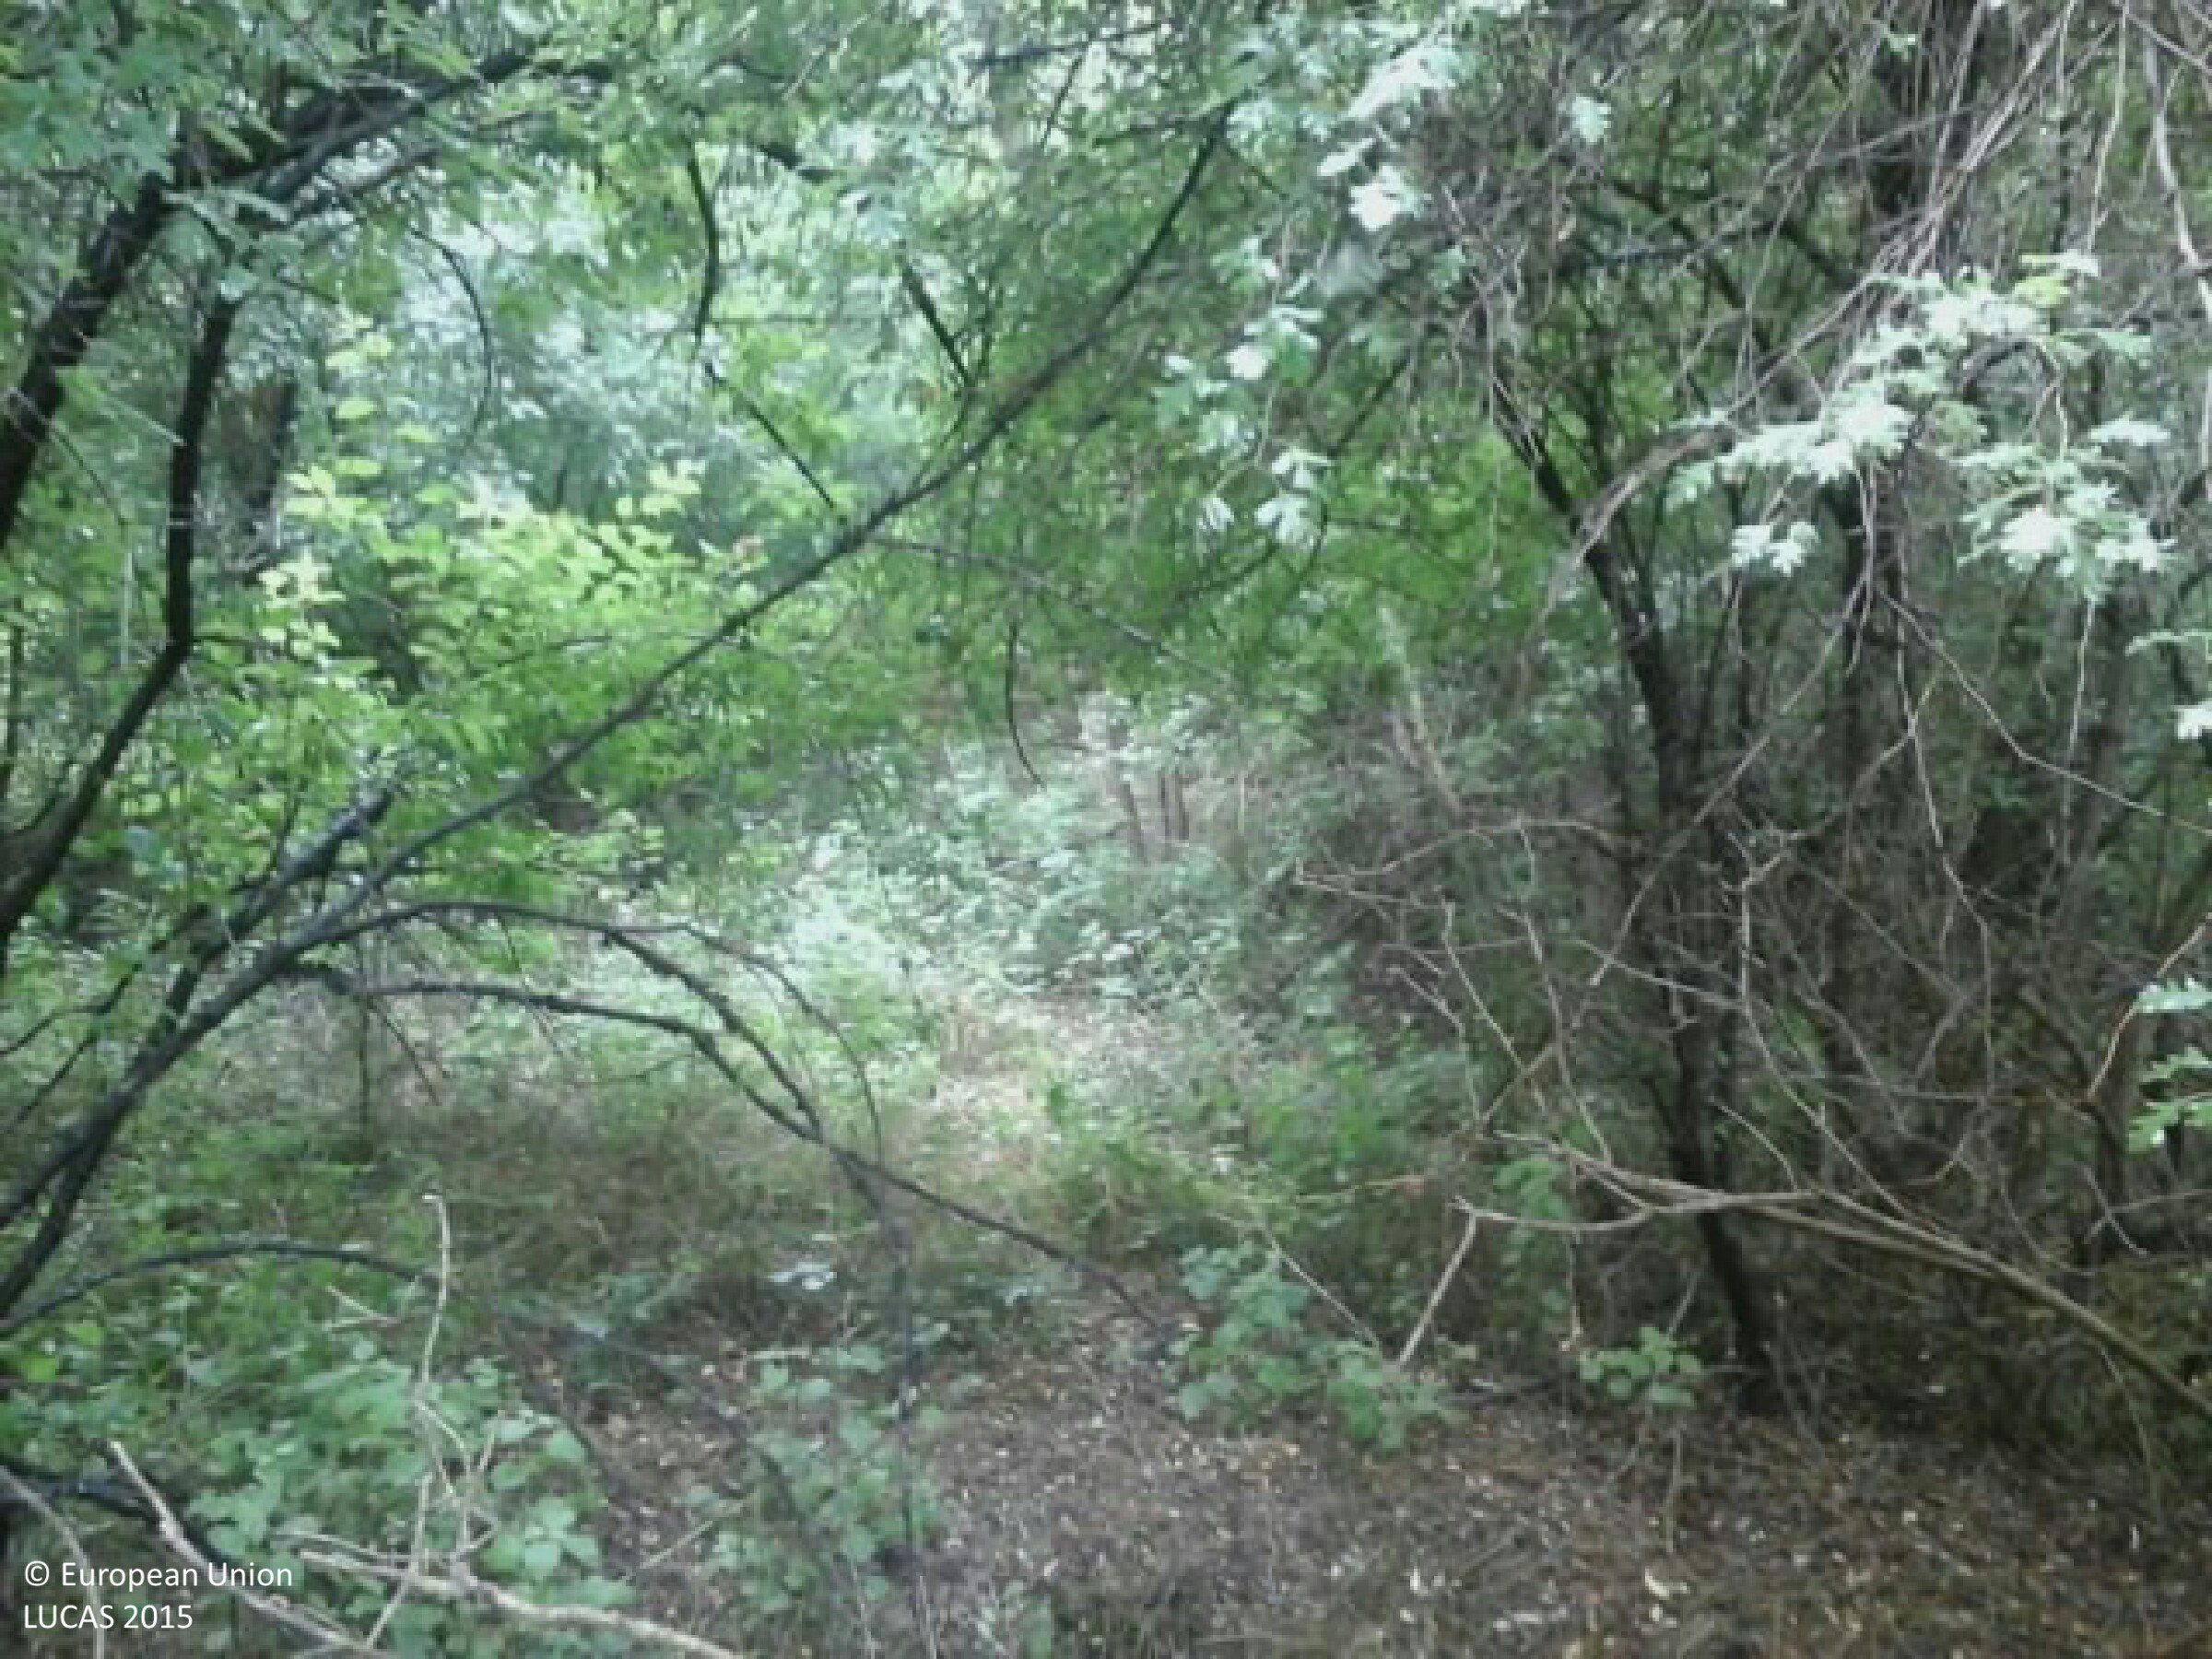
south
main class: Woodland
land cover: Broadleaved woodland
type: mesophytic deciduous forest
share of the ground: > 75 %
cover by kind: broadleaved forest trees 80 %, herbaceous plants 20 %
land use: Forestry
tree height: > 5 m
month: June
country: HU
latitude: 46.2429
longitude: 19.0003
